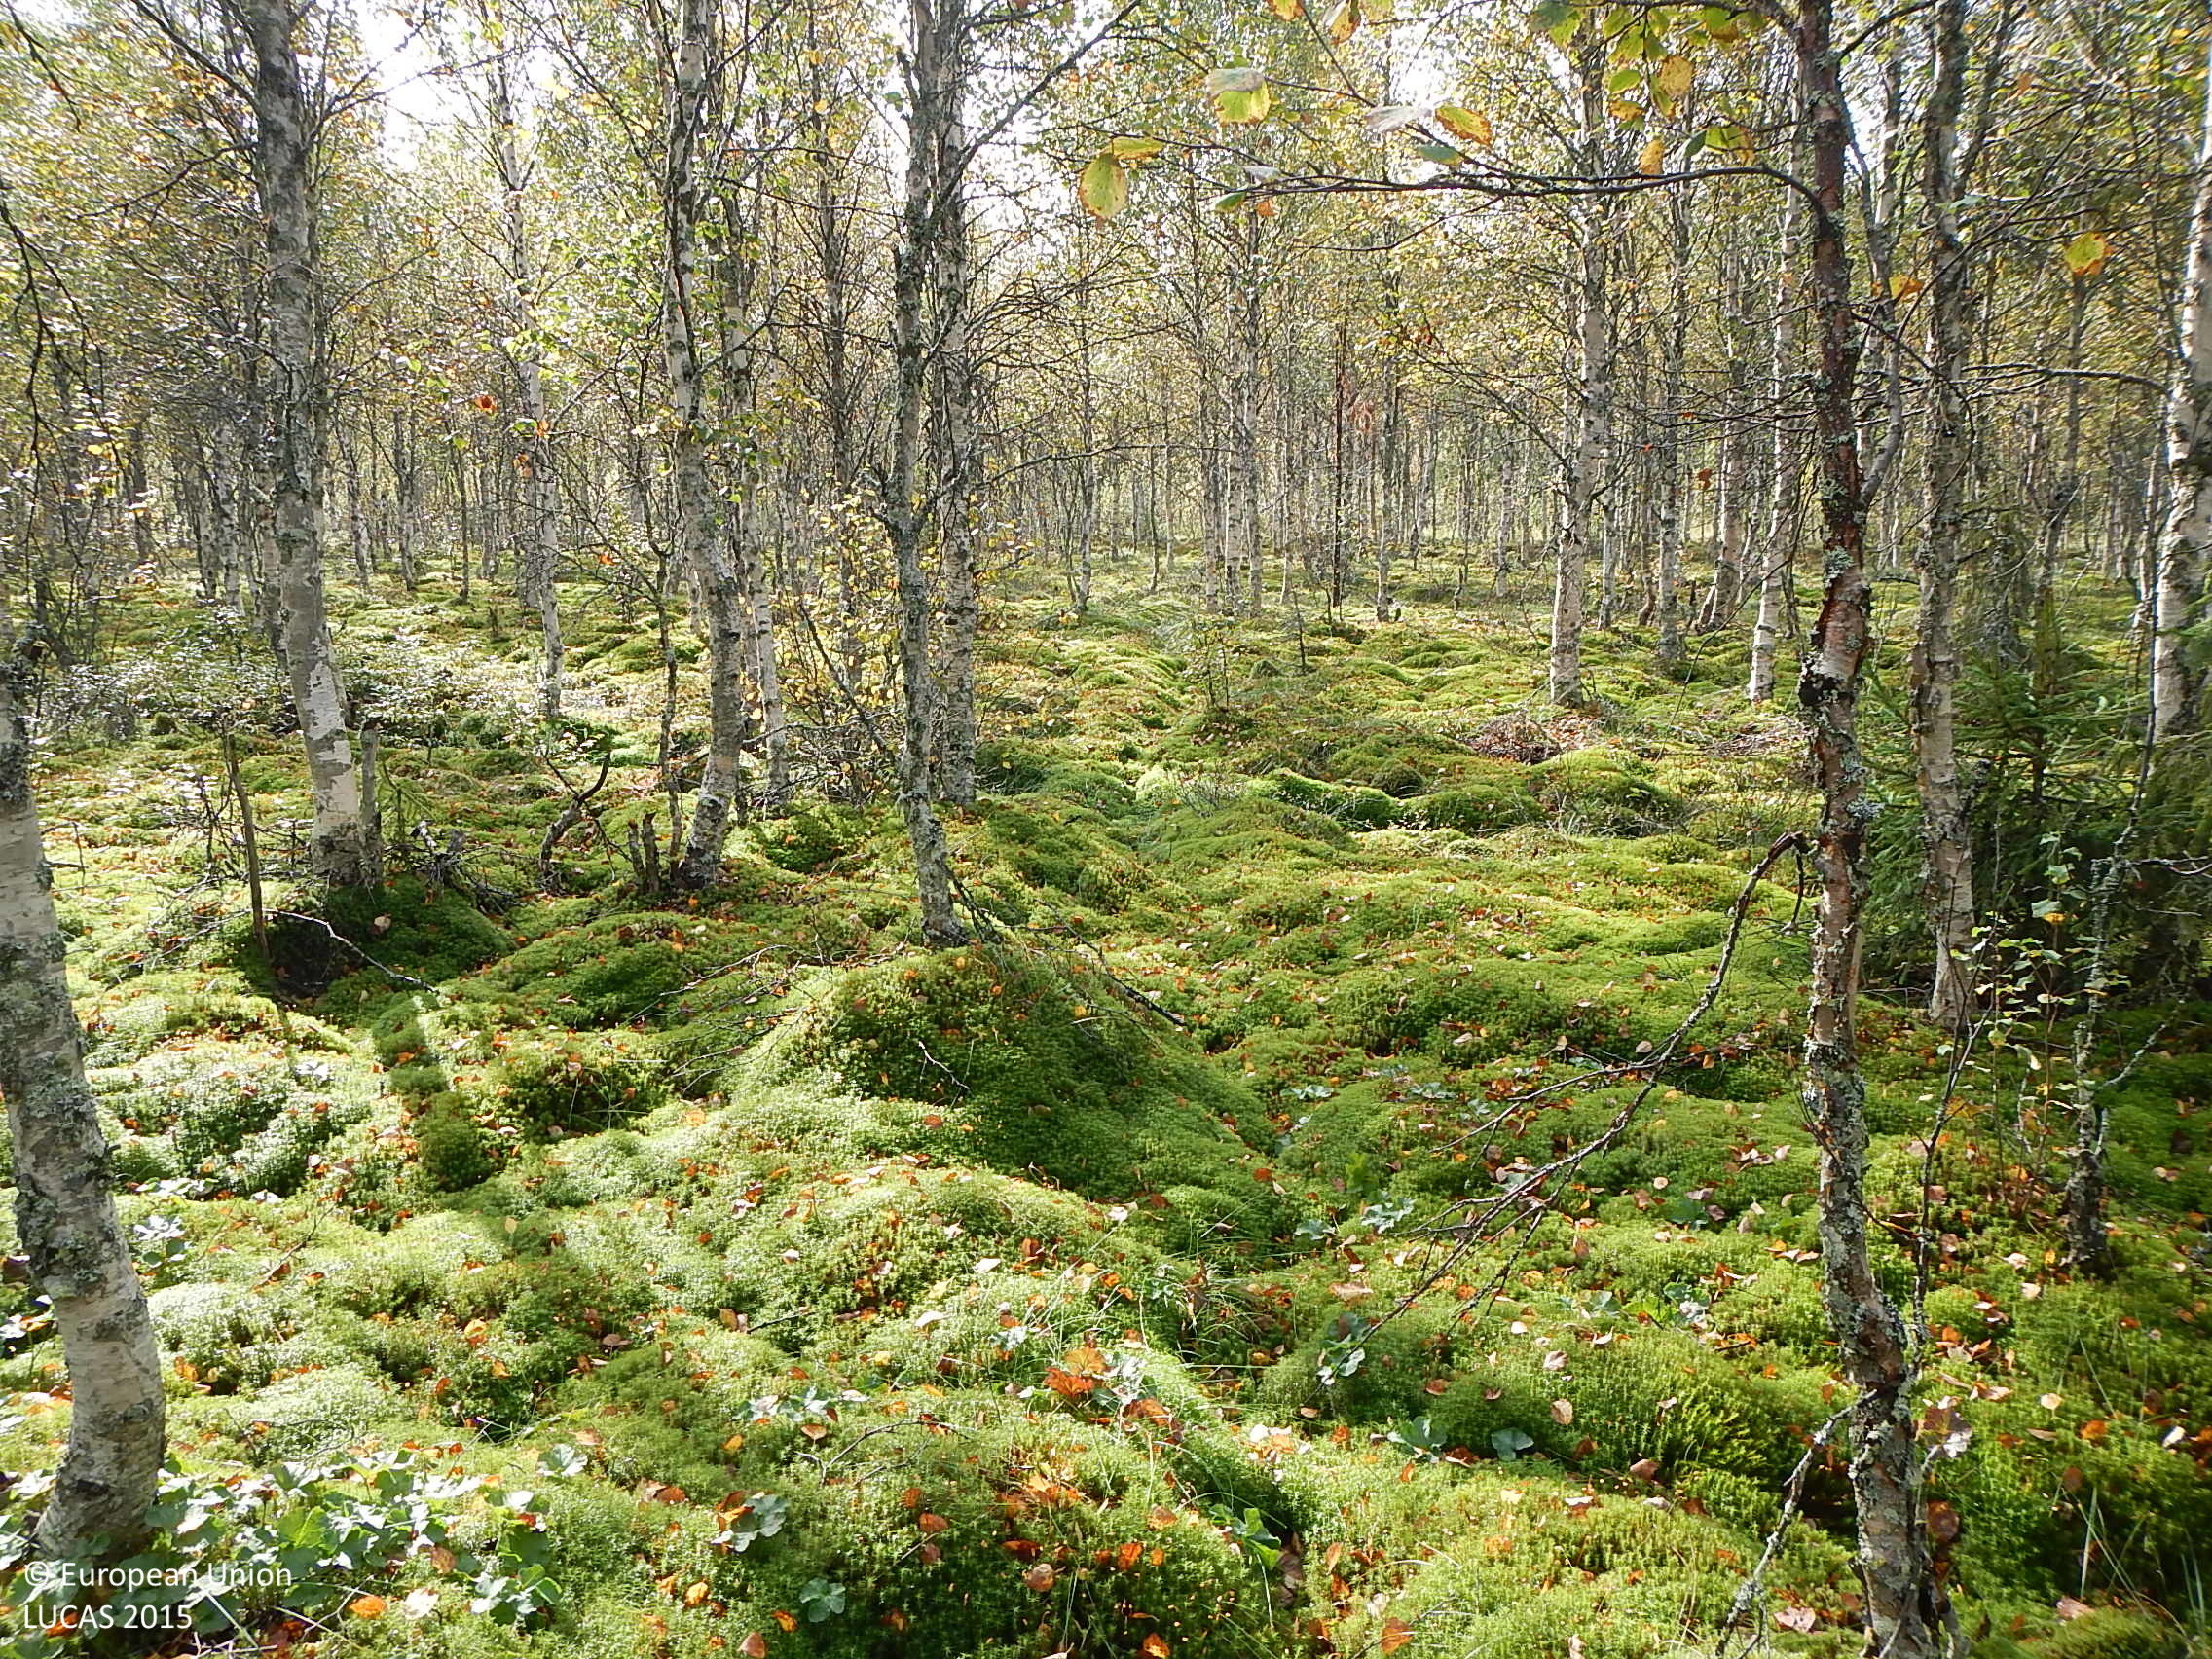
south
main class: Woodland
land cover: Broadleaved woodland
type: mire and swamp forests
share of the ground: > 75 %
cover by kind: broadleaved forest trees 75 %, lichens and mosses 20 %, herbaceous plants 5 %
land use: Forestry
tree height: > 5 m
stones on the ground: < 10 %
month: August
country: FI
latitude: 65.7415
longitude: 26.9719
